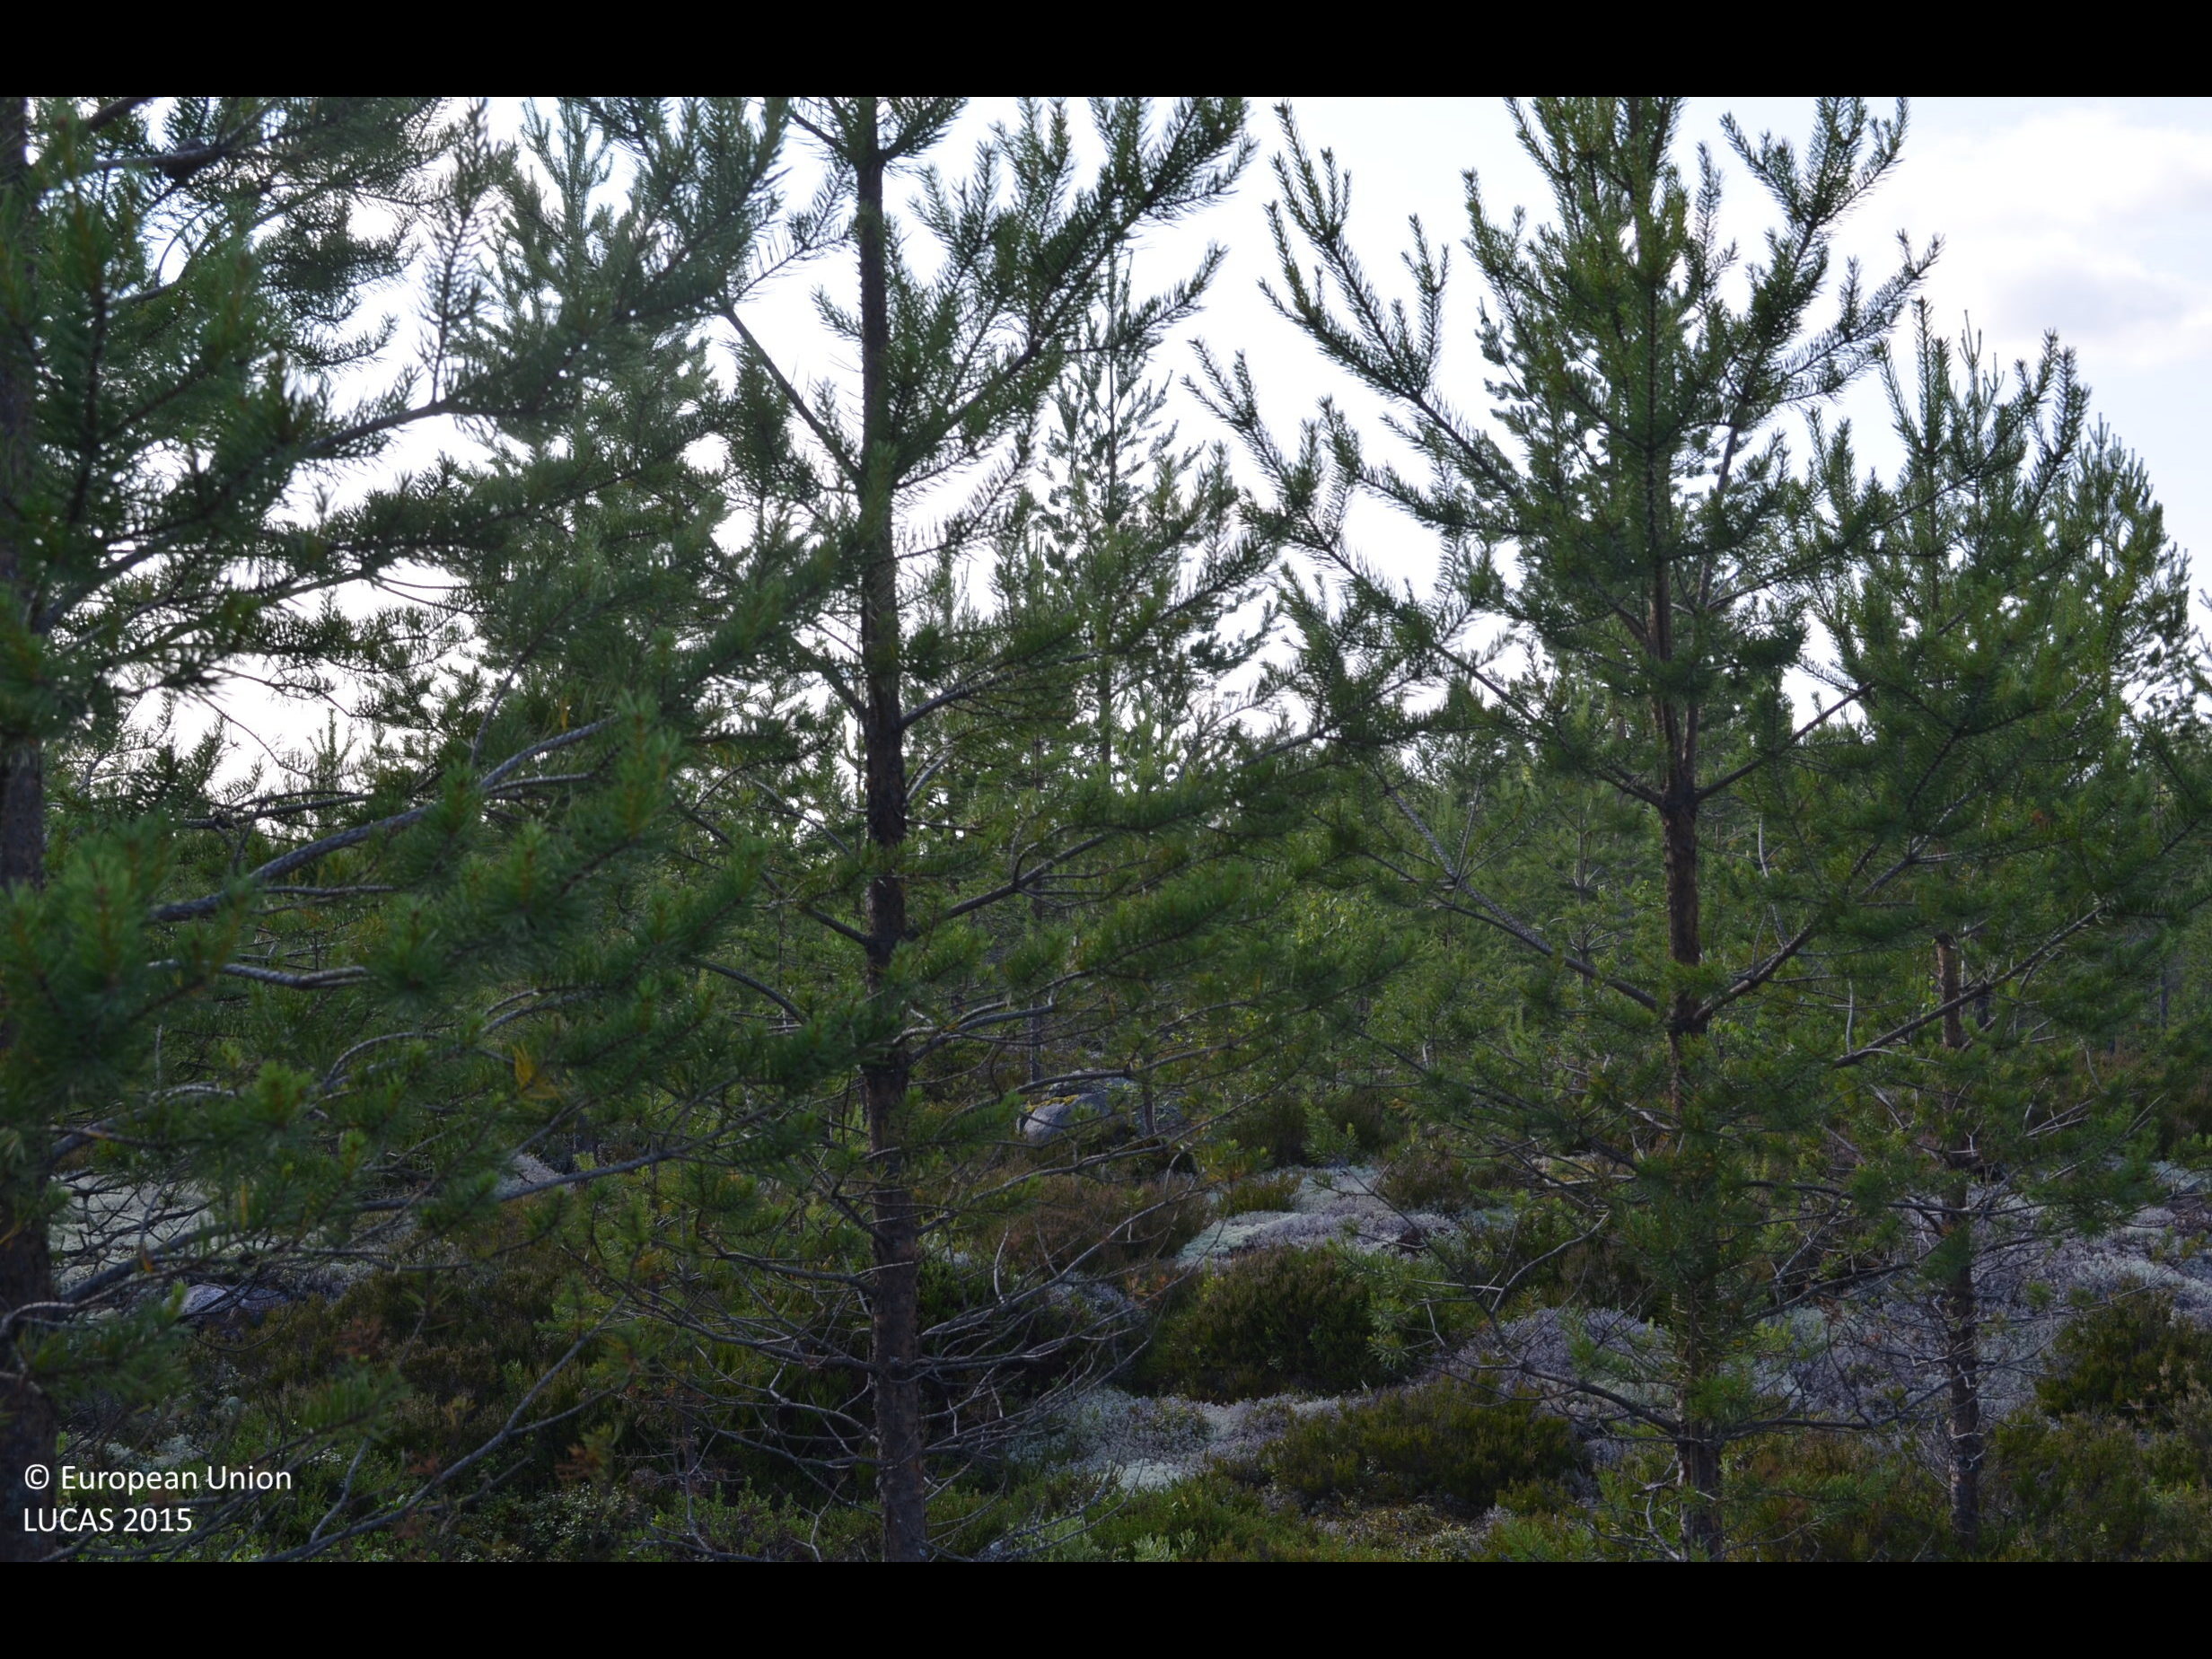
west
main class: Woodland
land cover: Pine dominated coniferous woodland
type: boreal forest
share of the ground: 50 - 75 %
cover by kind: coniferous forest trees 50 %, shrubs 35 %, lichens and mosses 15 %
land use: Forestry
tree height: < 5 m
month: July
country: FI
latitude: 62.3392
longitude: 23.6098
